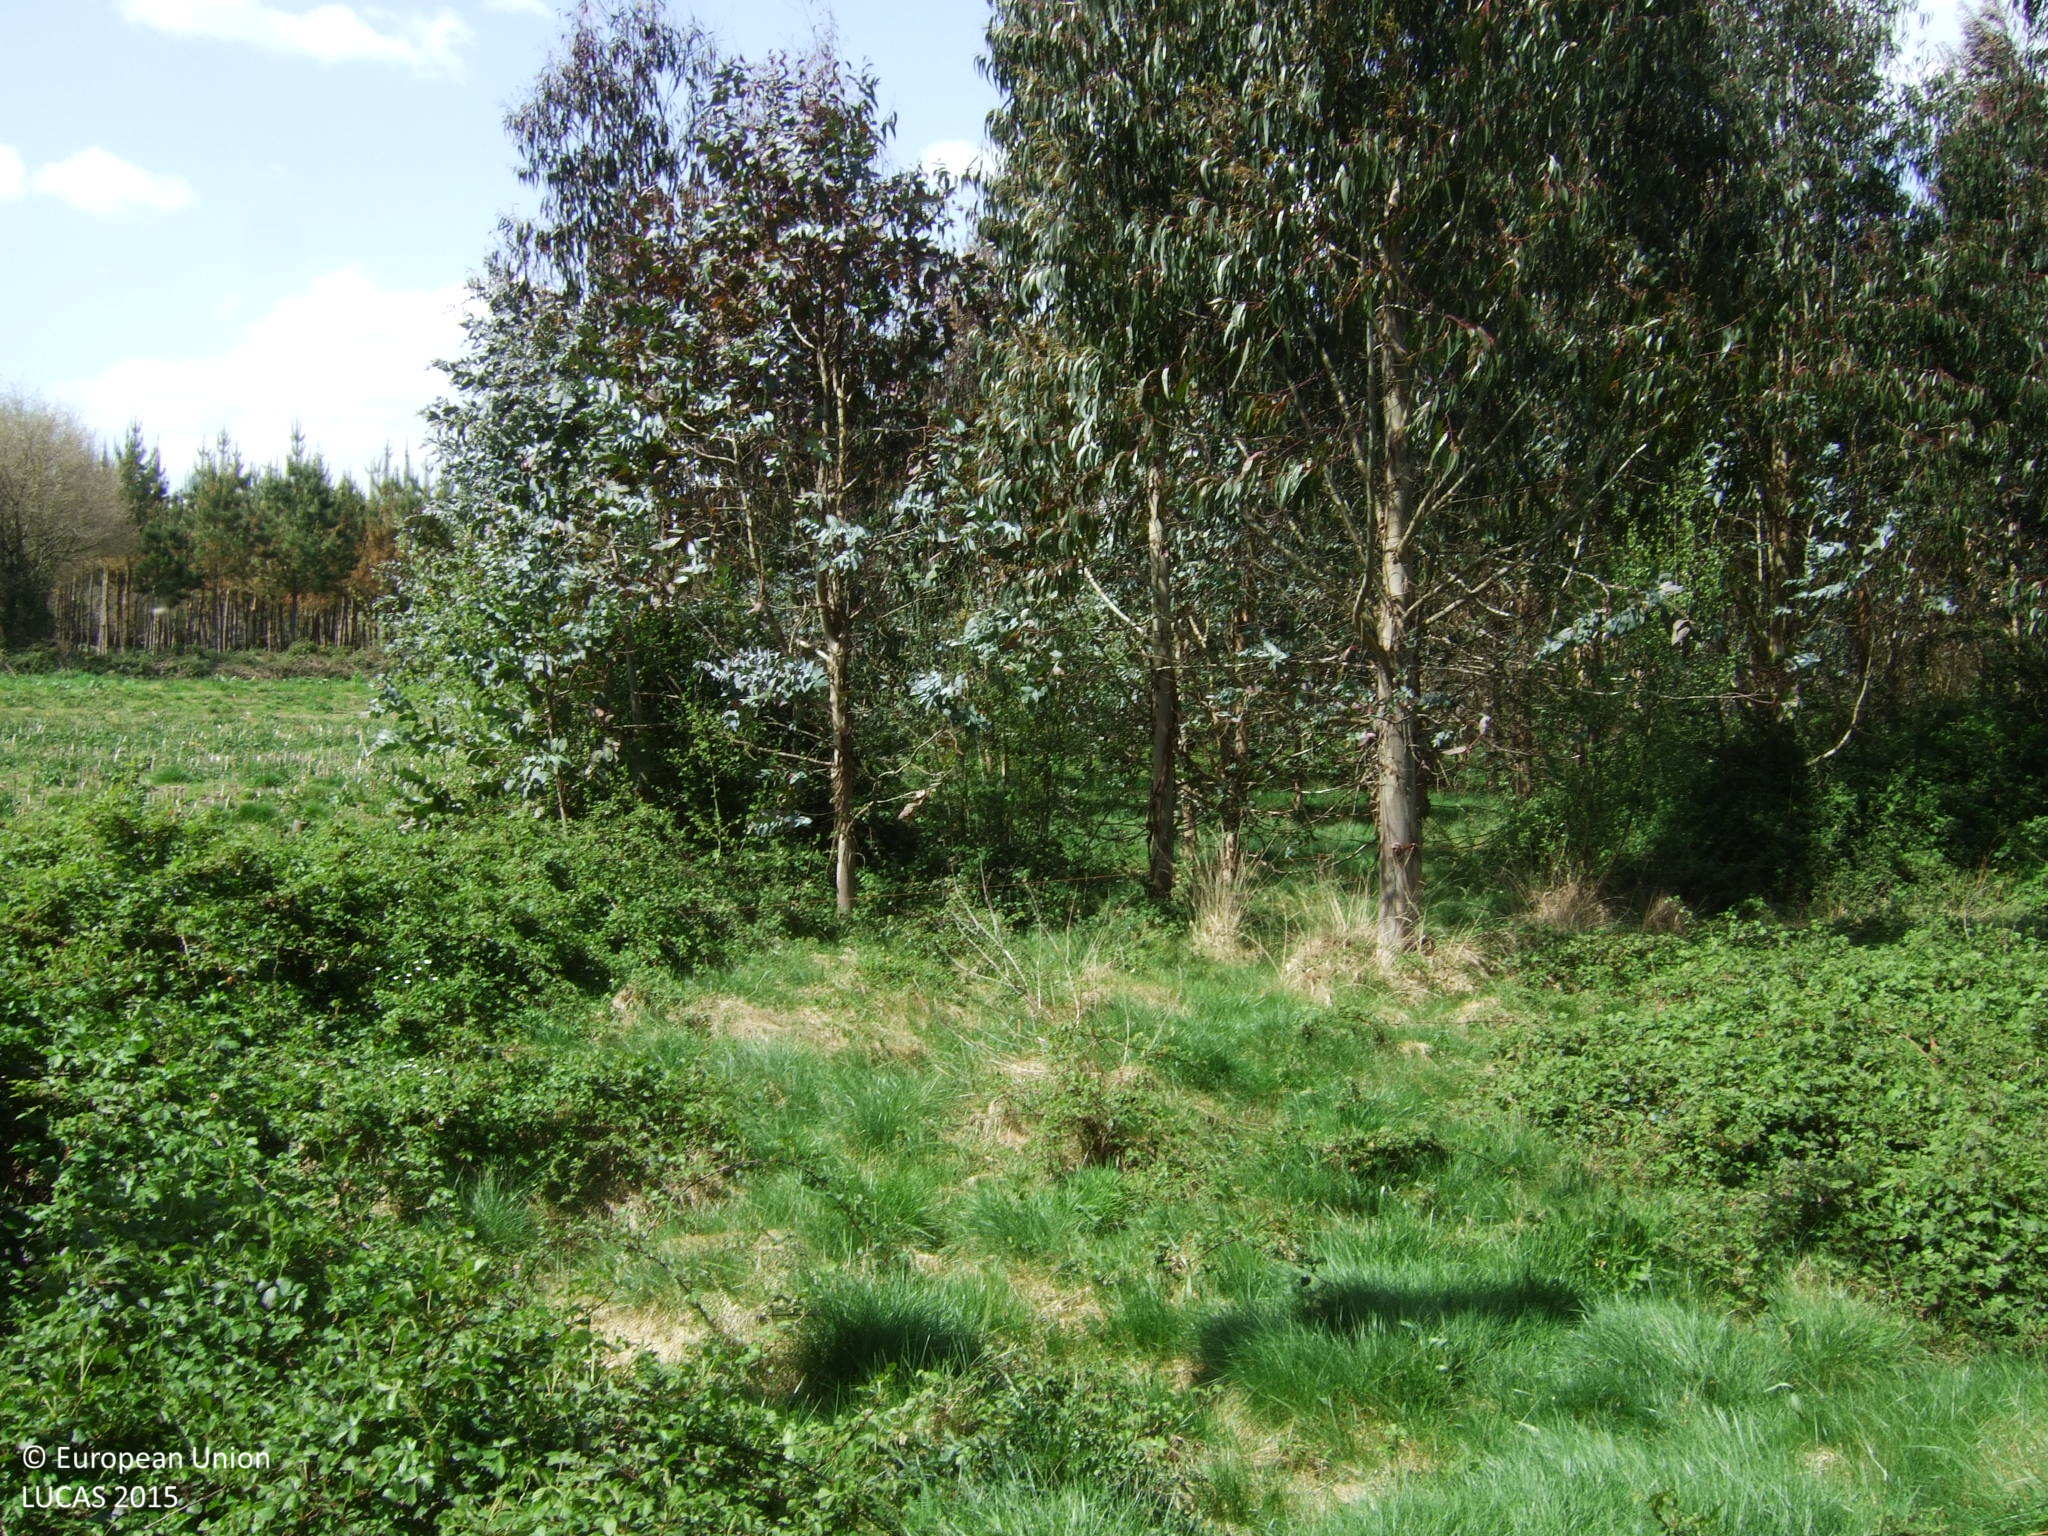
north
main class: Woodland
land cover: Broadleaved woodland
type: acidophilous oak and oak-birch forest
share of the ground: 50 - 75 %
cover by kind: broadleaved forest trees 65 %, shrubs 35 %
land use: Forestry
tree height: > 5 m
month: April
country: ES
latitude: 42.9572
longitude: -7.6198
